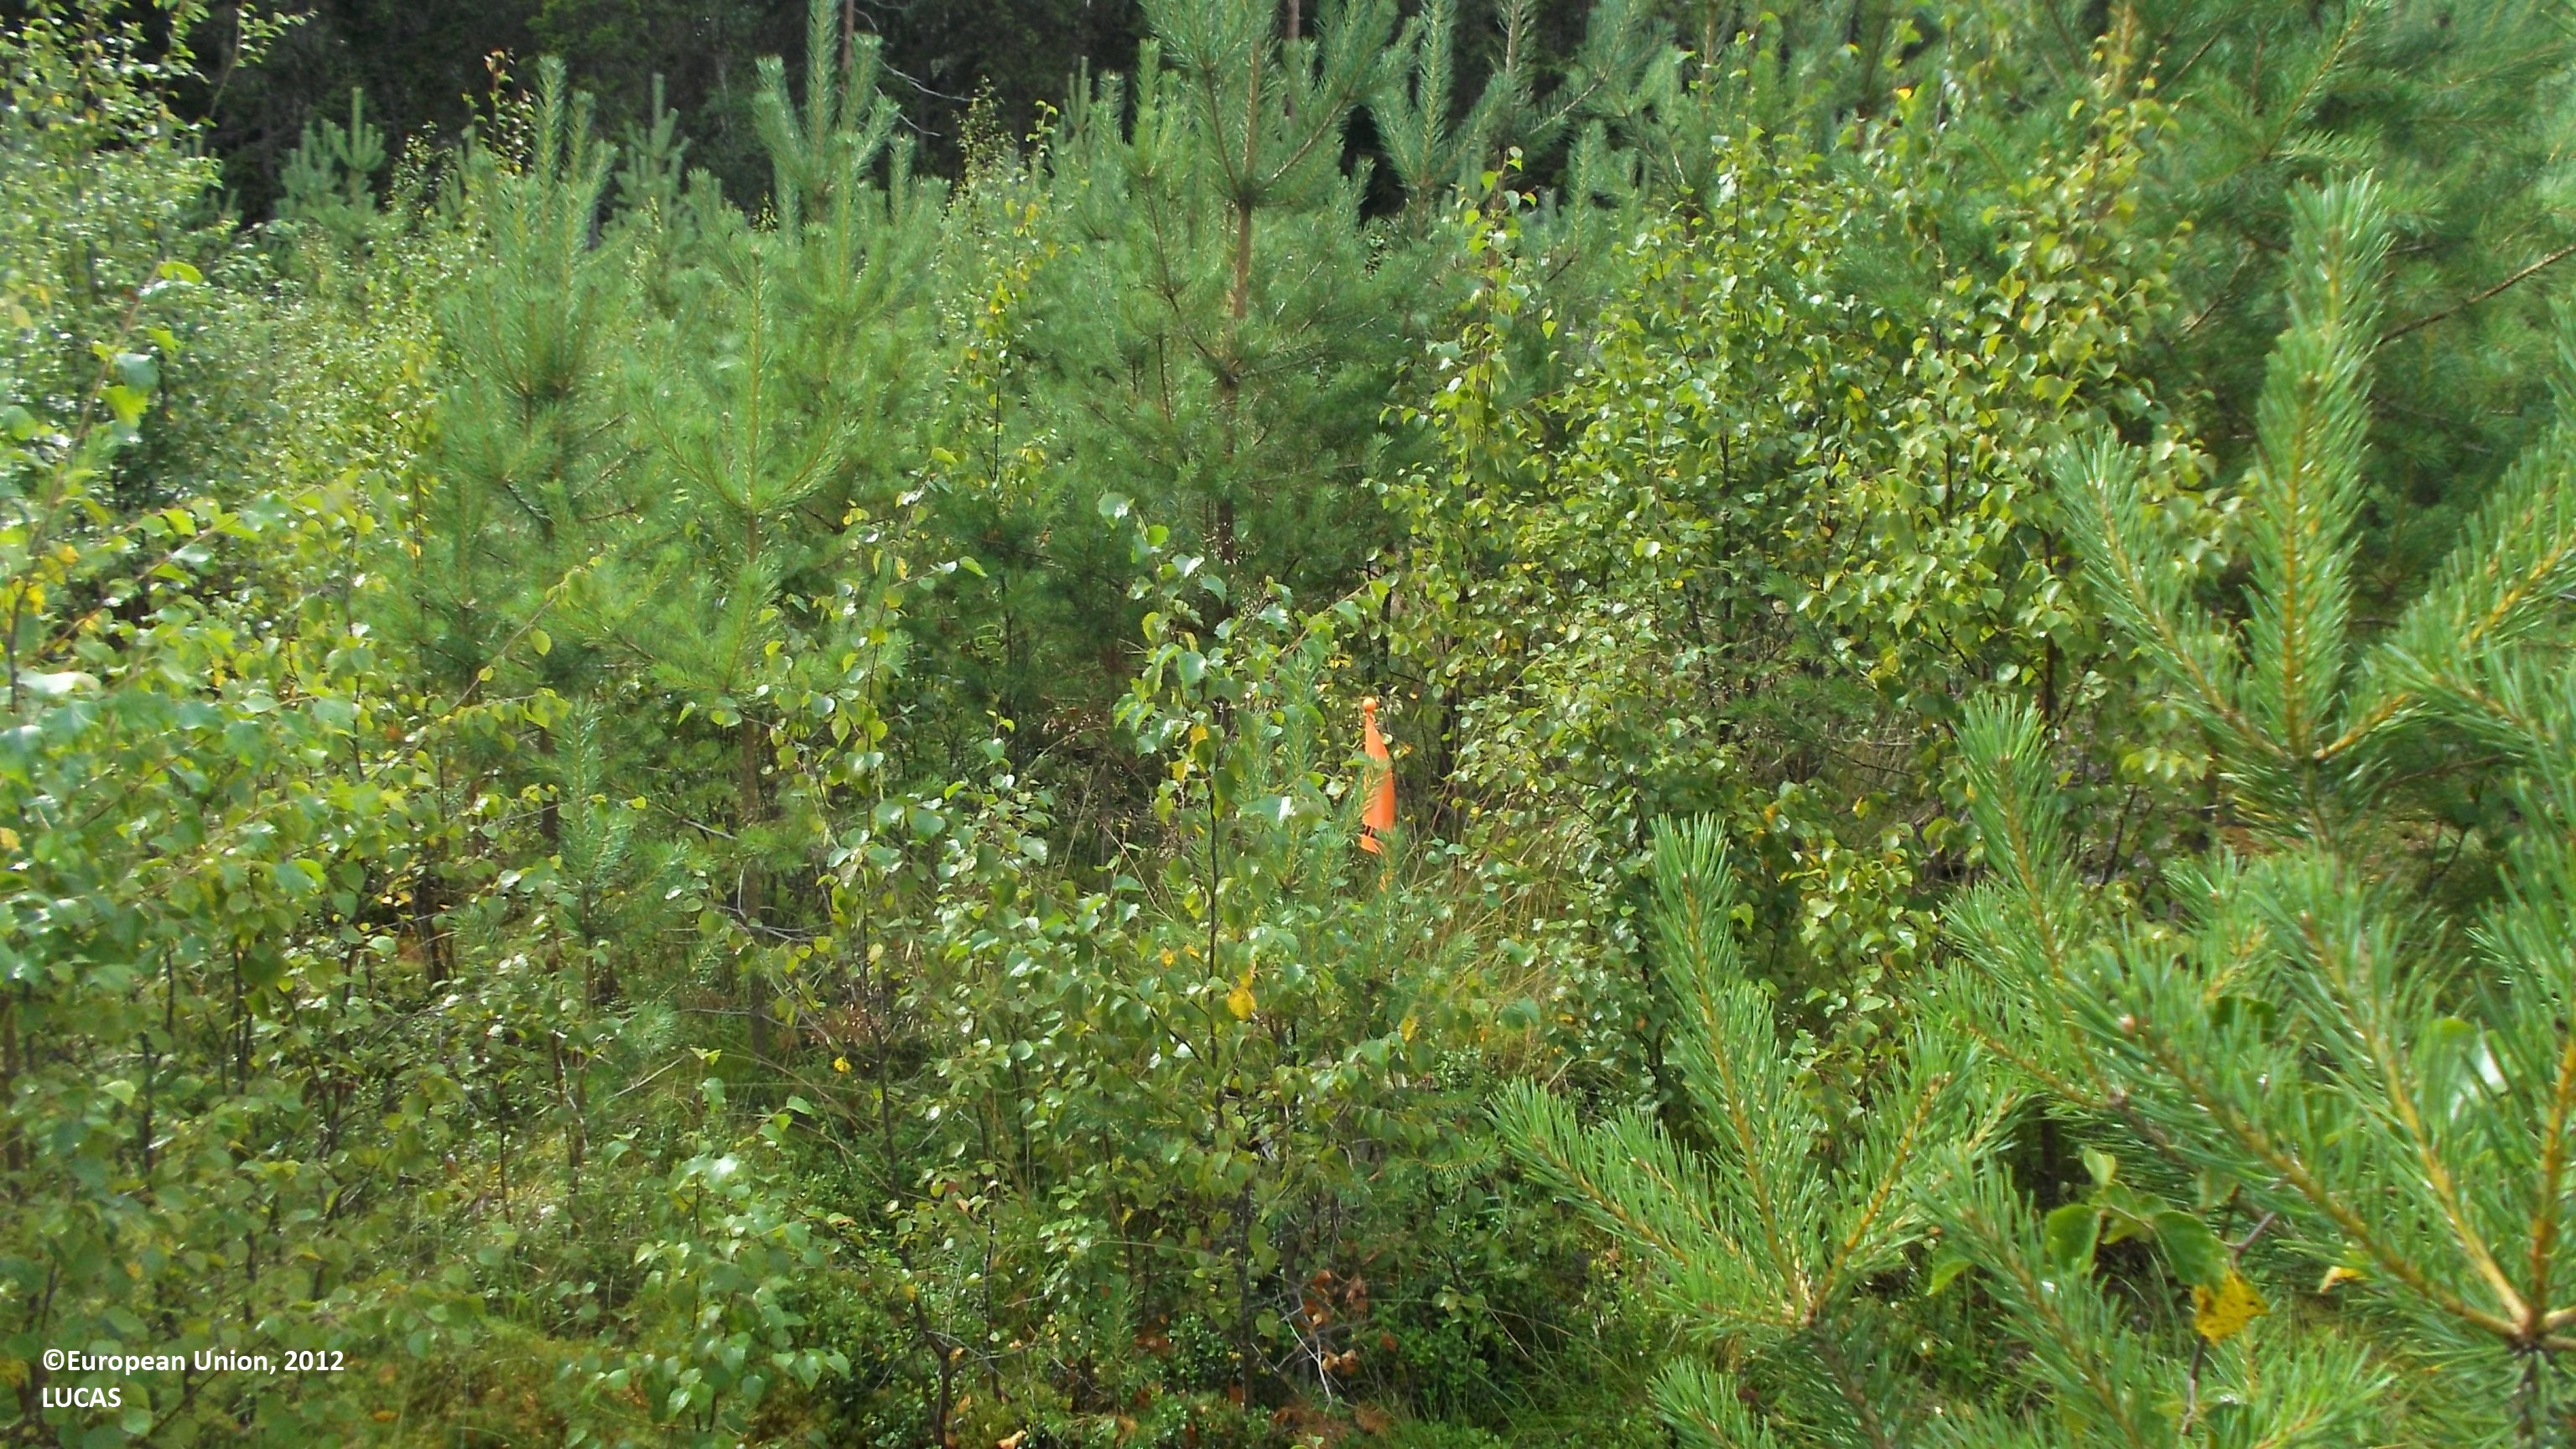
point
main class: Woodland
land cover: Other mixed woodland
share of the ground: 25 - 50 %
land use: Forestry
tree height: < 5 m
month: August
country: FI
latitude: 63.9216
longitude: 23.5768
